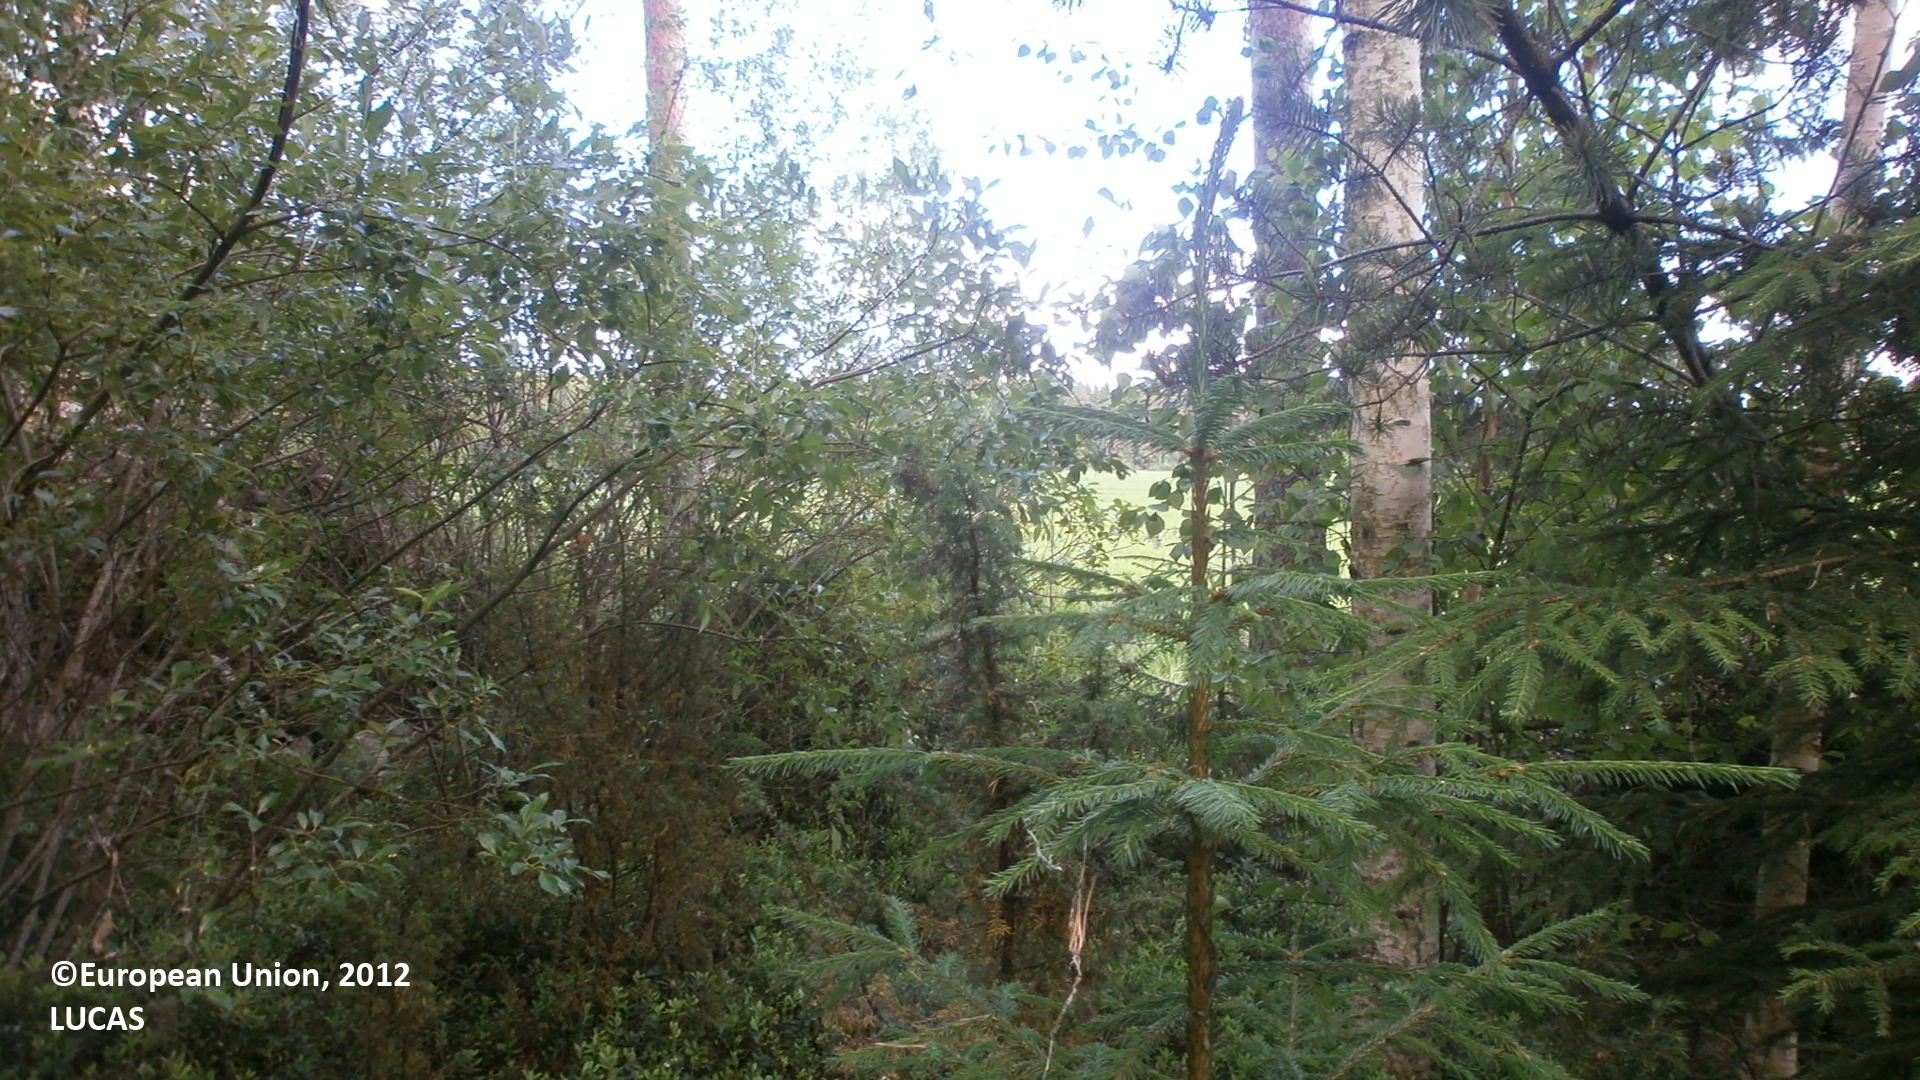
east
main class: Woodland
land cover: Pine dominated mixed woodland
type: boreal forest
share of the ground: > 75 %
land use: Forestry
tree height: > 5 m
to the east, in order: Pine dominated mixed woodland; Ditches and canals; Grass margins; Oats; Shruby margins; Ditches and canals; Broadleaved woodland
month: July
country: FI
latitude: 63.9608
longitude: 24.7602
